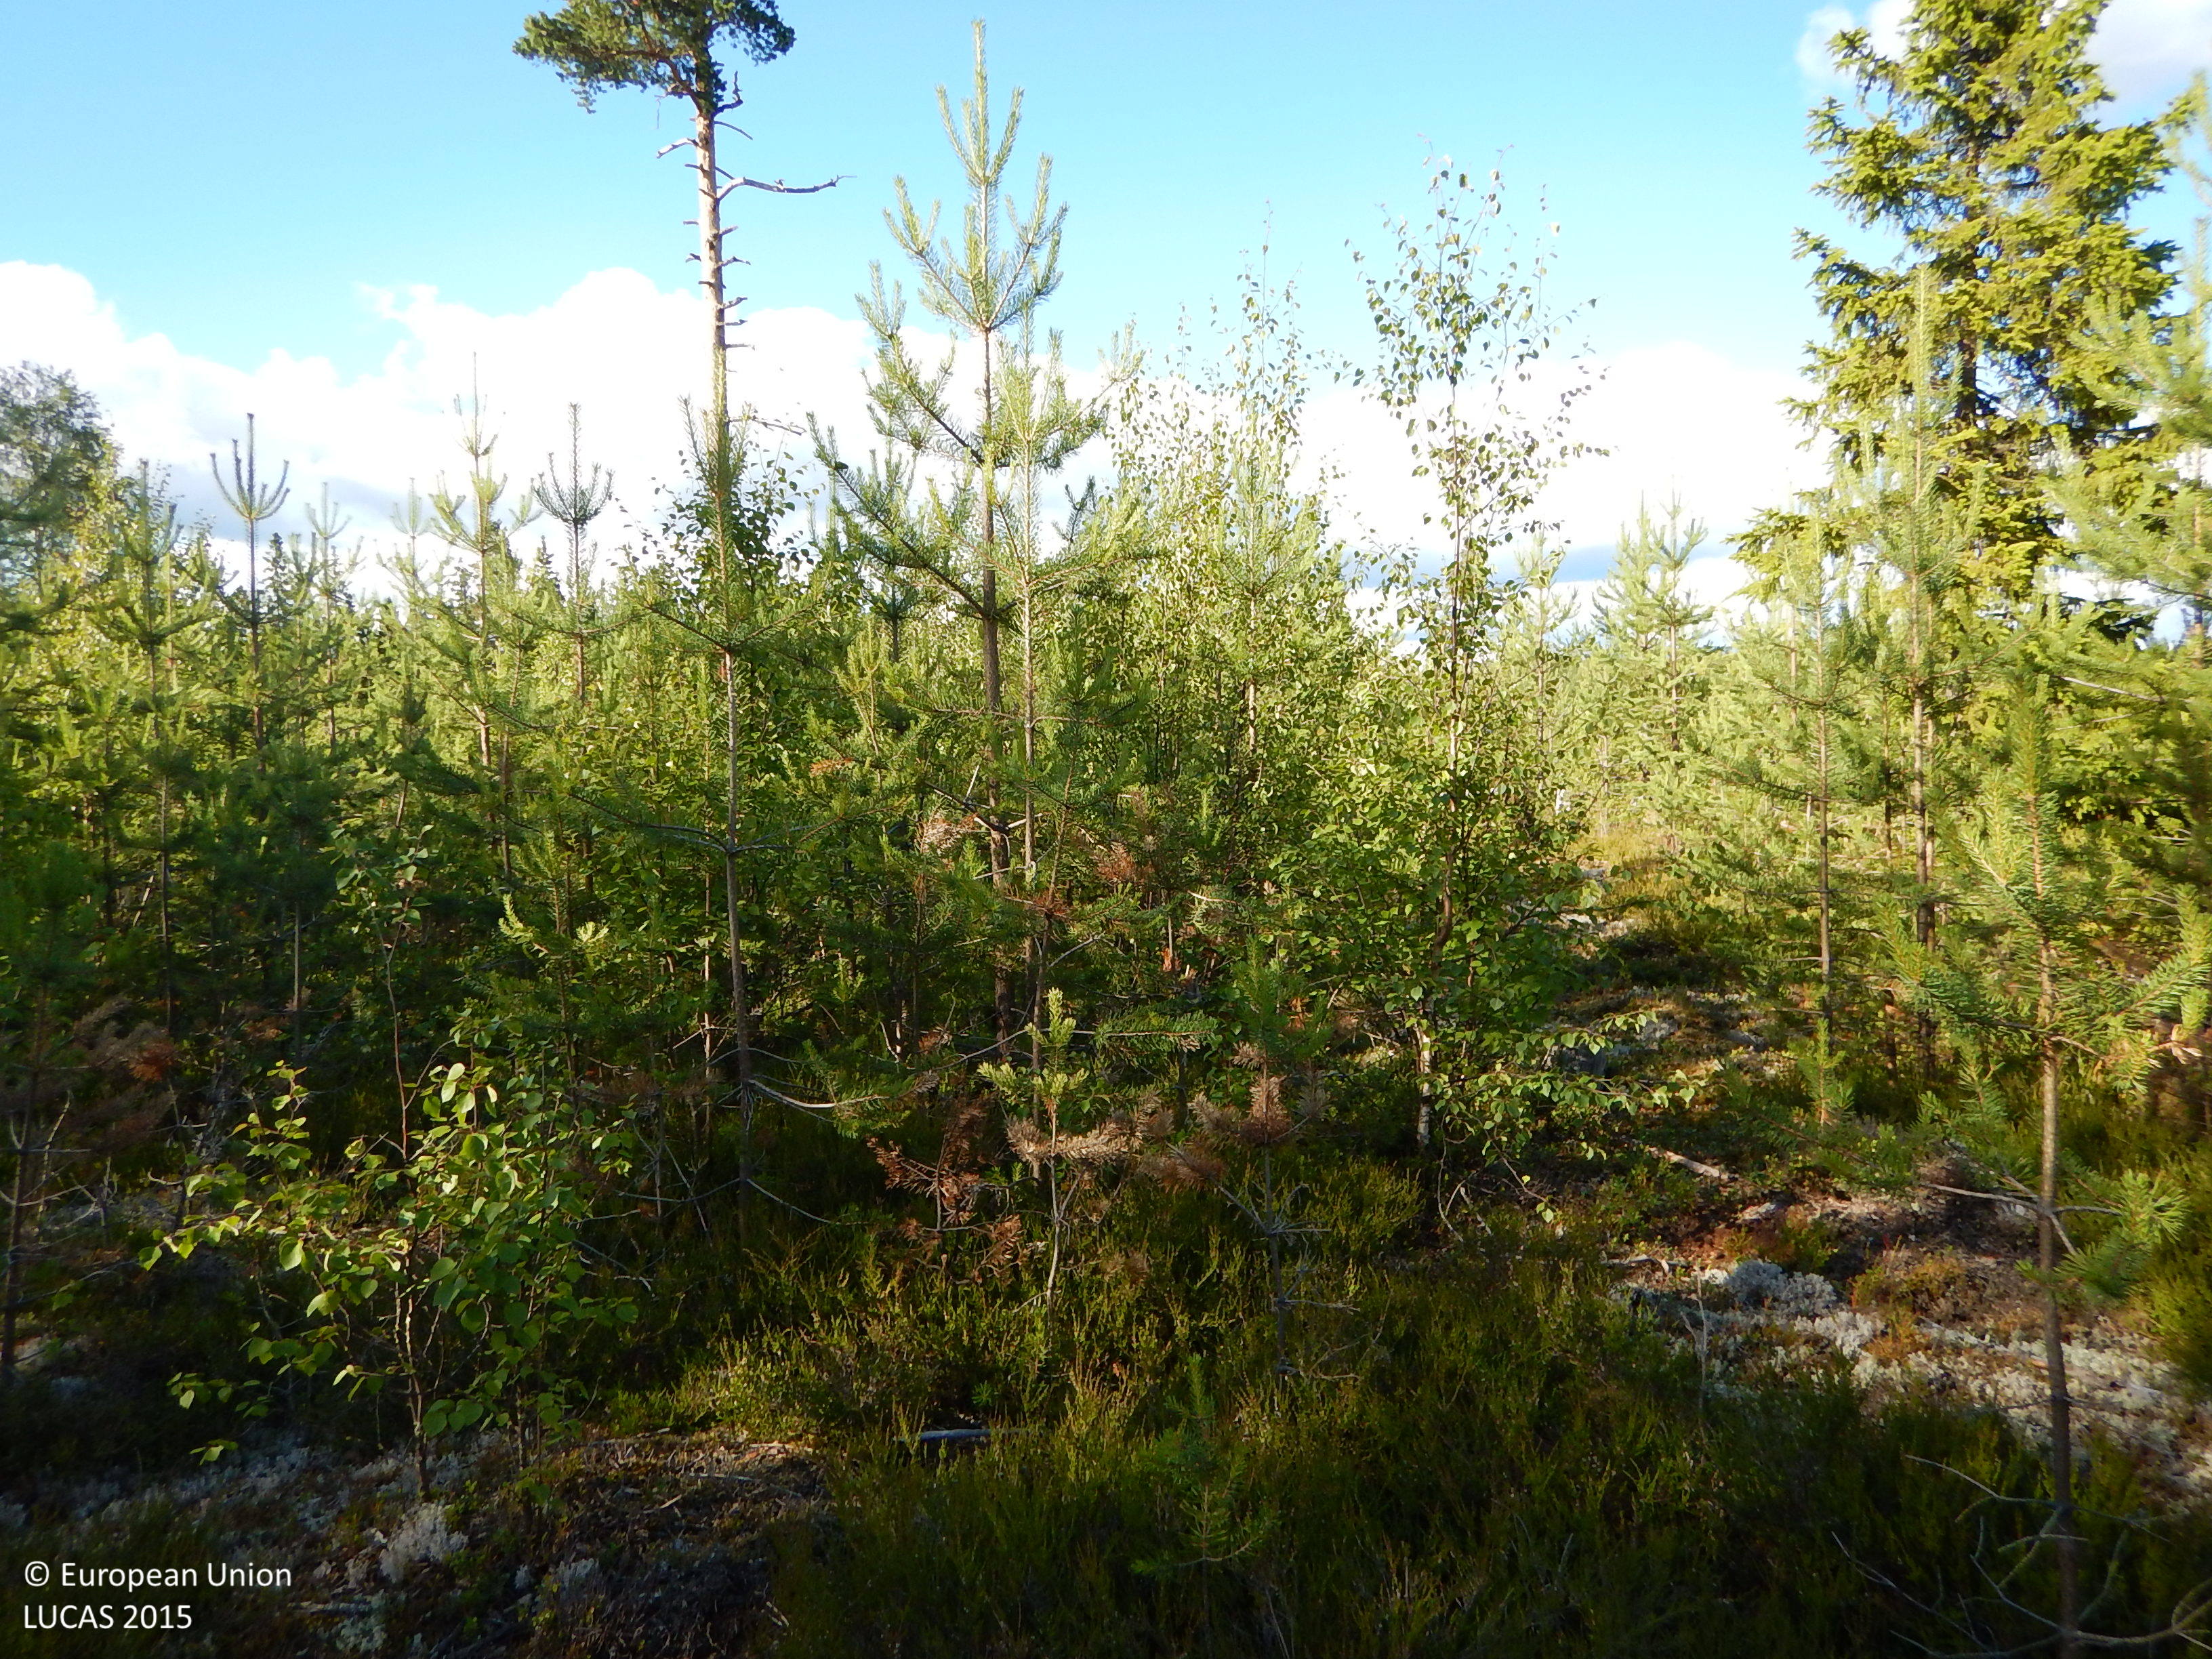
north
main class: Woodland
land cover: Pine dominated mixed woodland
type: boreal forest
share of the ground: 25 - 50 %
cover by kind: coniferous forest trees 25 %, shrubs 25 %, broadleaved forest trees 20 %, herbaceous plants 20 %, lichens and mosses 10 %
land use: Forestry
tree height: < 5 m
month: July
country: SE
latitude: 64.8071
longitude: 20.9046
